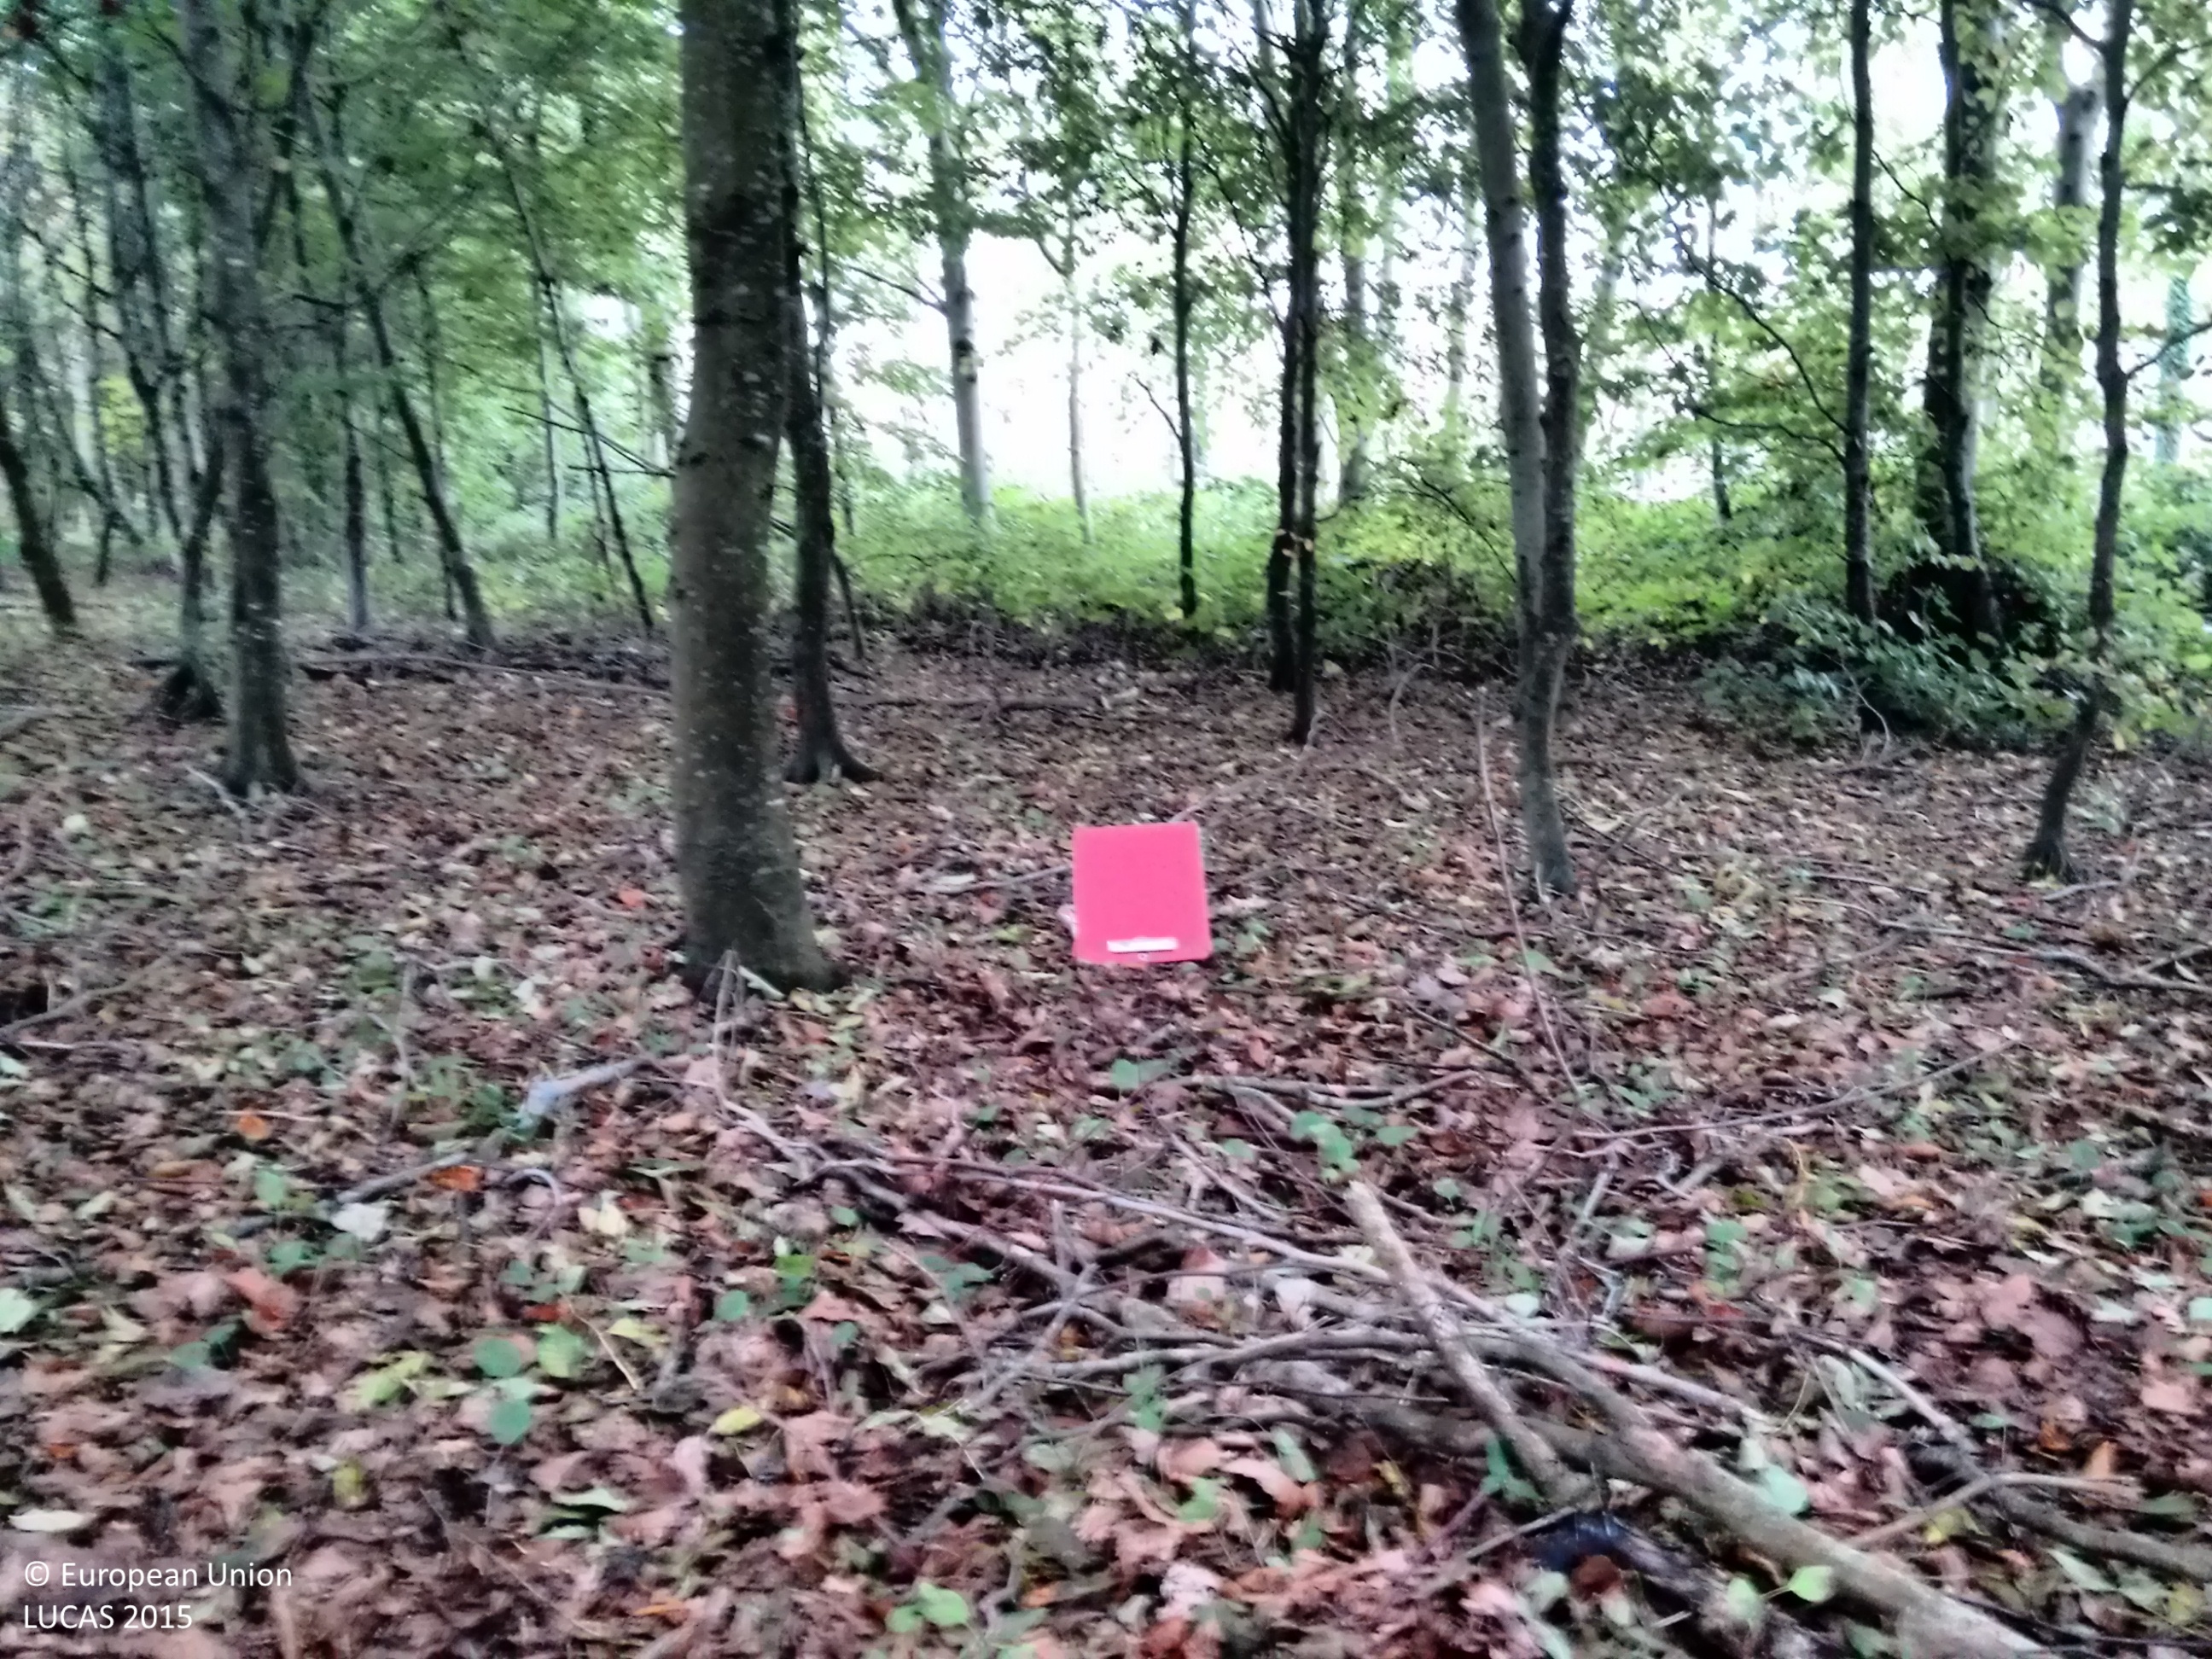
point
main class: Woodland
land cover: Broadleaved woodland
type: mesophytic deciduous forest
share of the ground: > 75 %
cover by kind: broadleaved forest trees 100 %
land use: Forestry
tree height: > 5 m
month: October
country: IE
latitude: 53.1033
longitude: -7.7778
